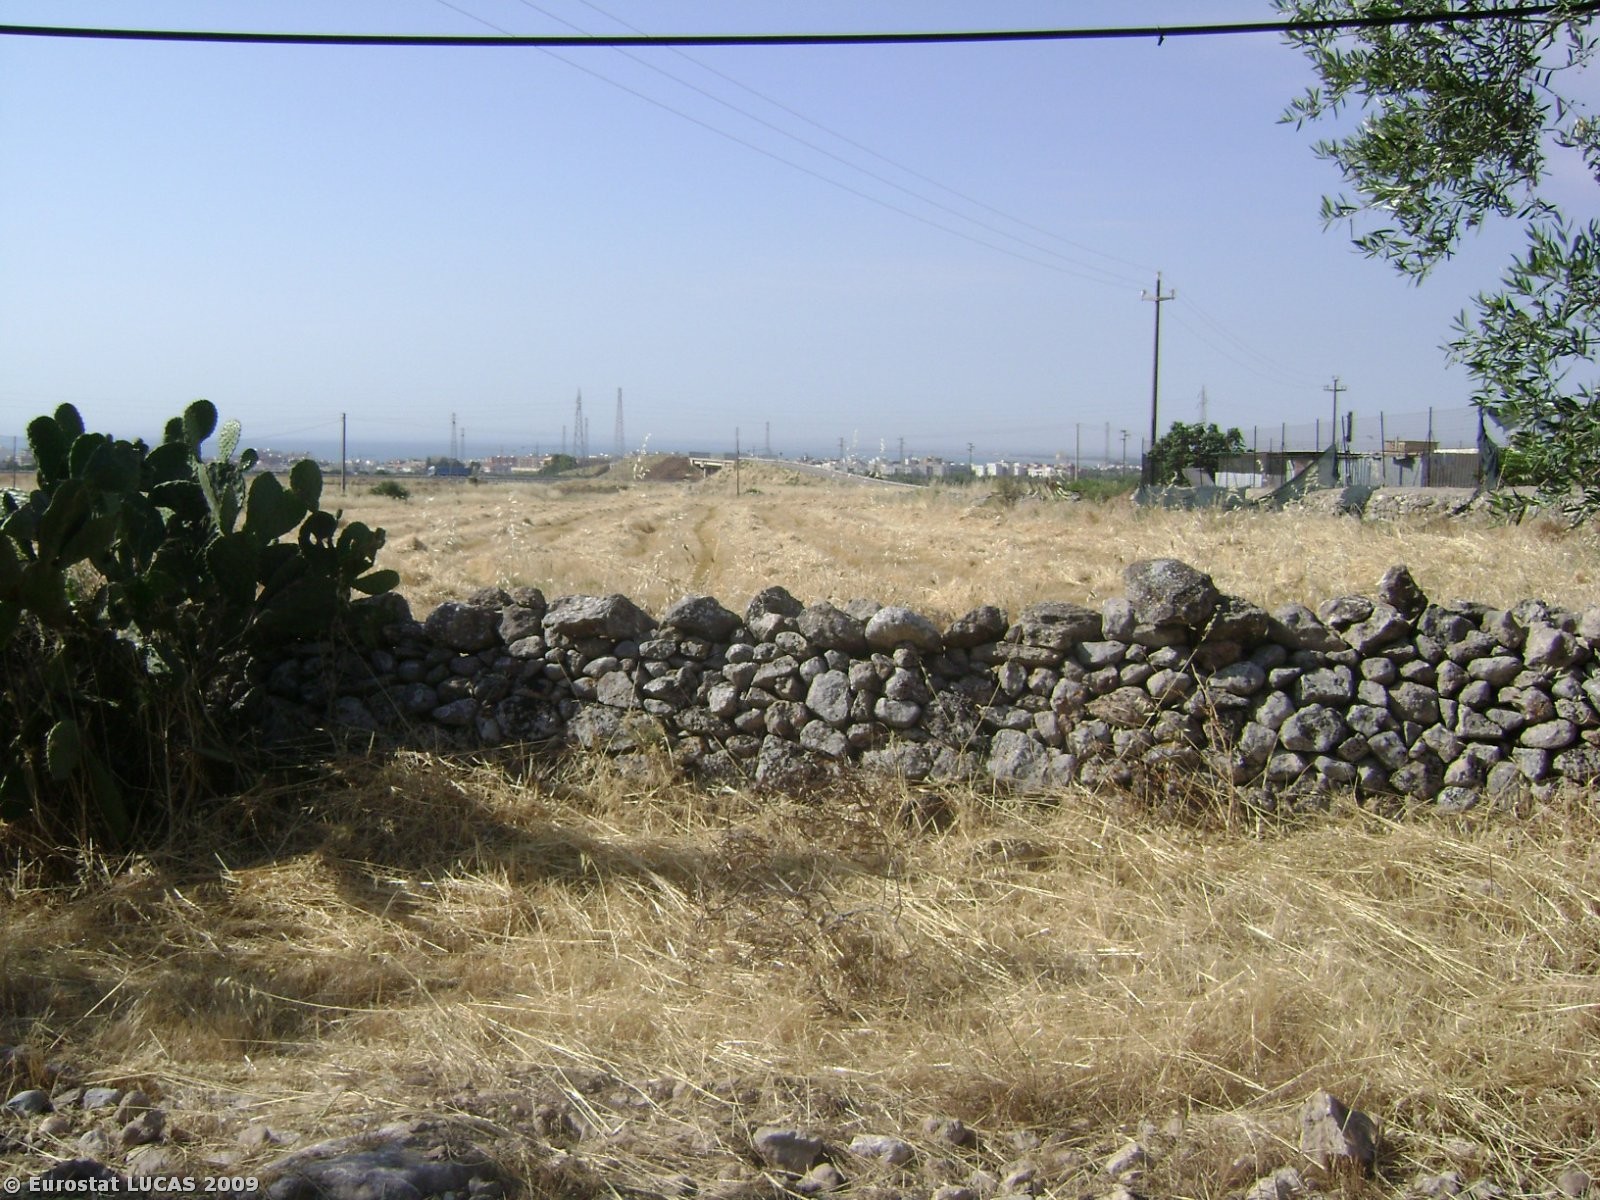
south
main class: Cropland
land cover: Olive groves
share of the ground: 50 - 75 %
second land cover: Bare land
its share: < 10 %
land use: Agriculture (excluding fallow land and kitchen gardens)
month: June
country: IT
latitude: 41.6488
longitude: 15.9019
